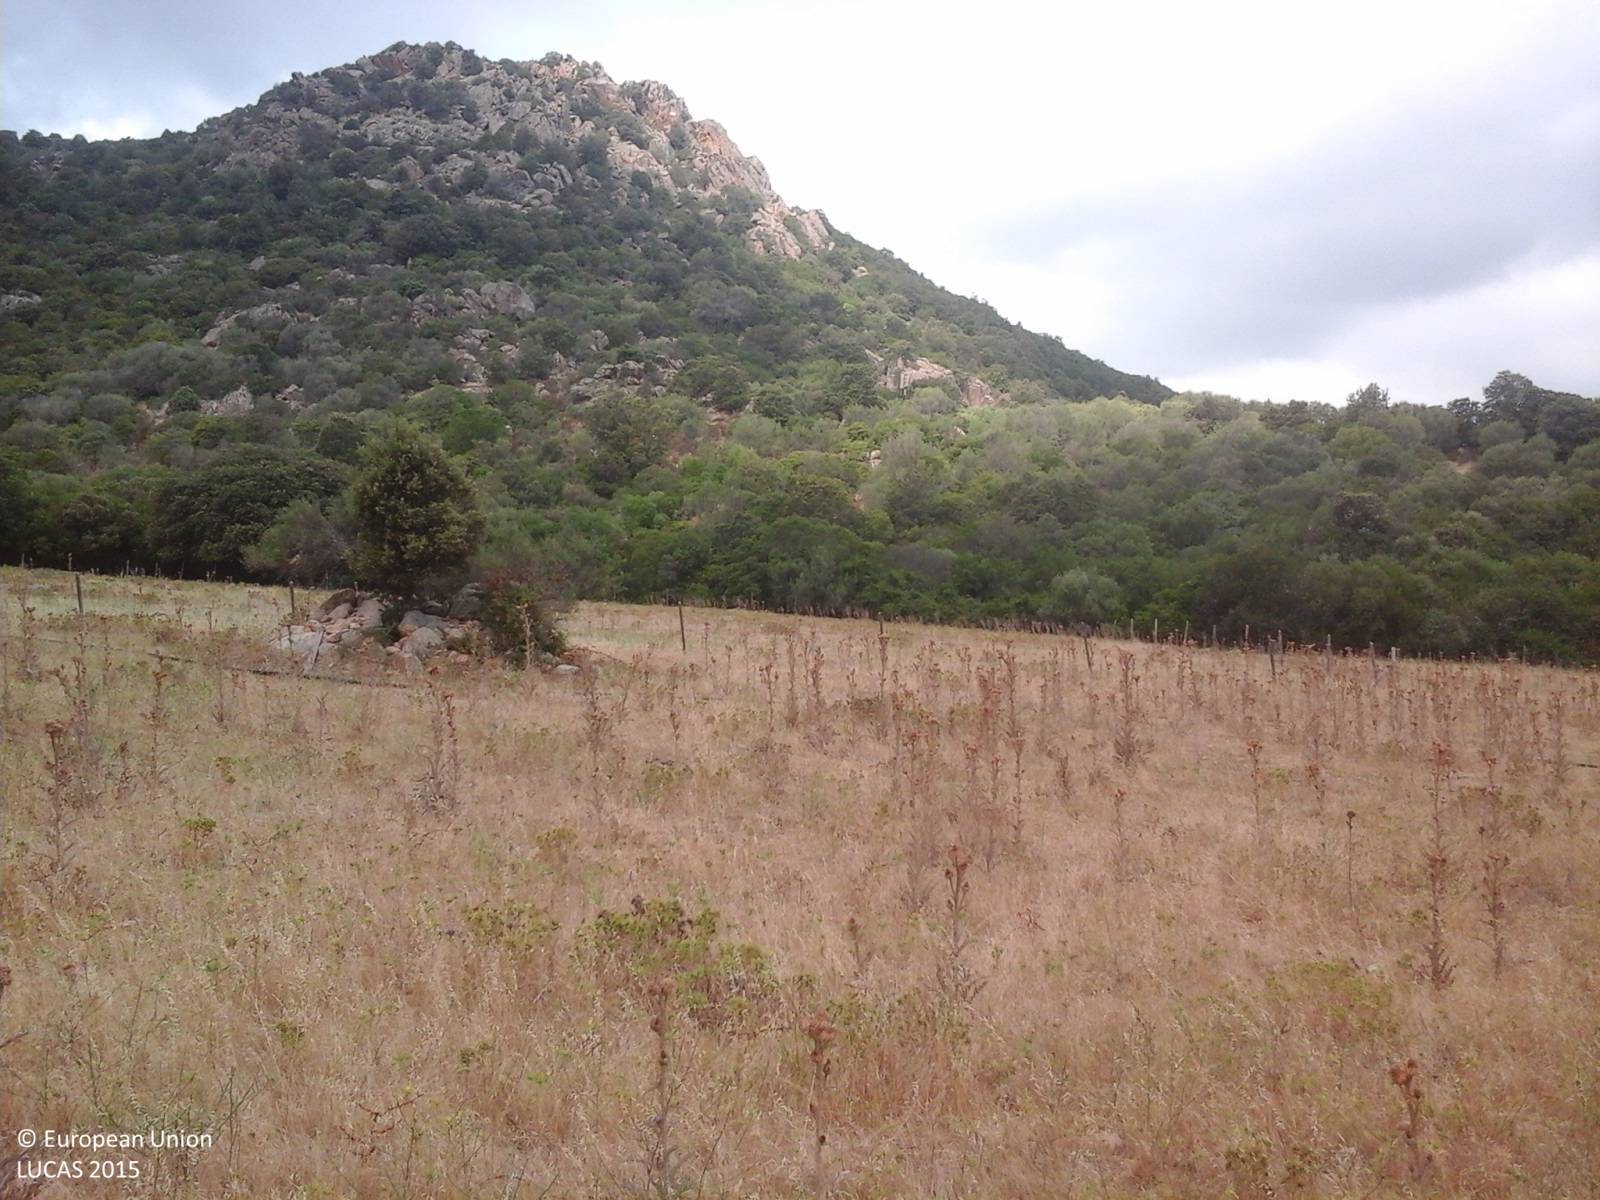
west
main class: Grassland
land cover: Grassland without tree/shrub cover
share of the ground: > 75 %
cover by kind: herbaceous plants 95 %, unconsolidated bare surface 5 %
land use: Agriculture (excluding fallow land and kitchen gardens)
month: July
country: IT
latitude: 40.7726
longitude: 9.4694
